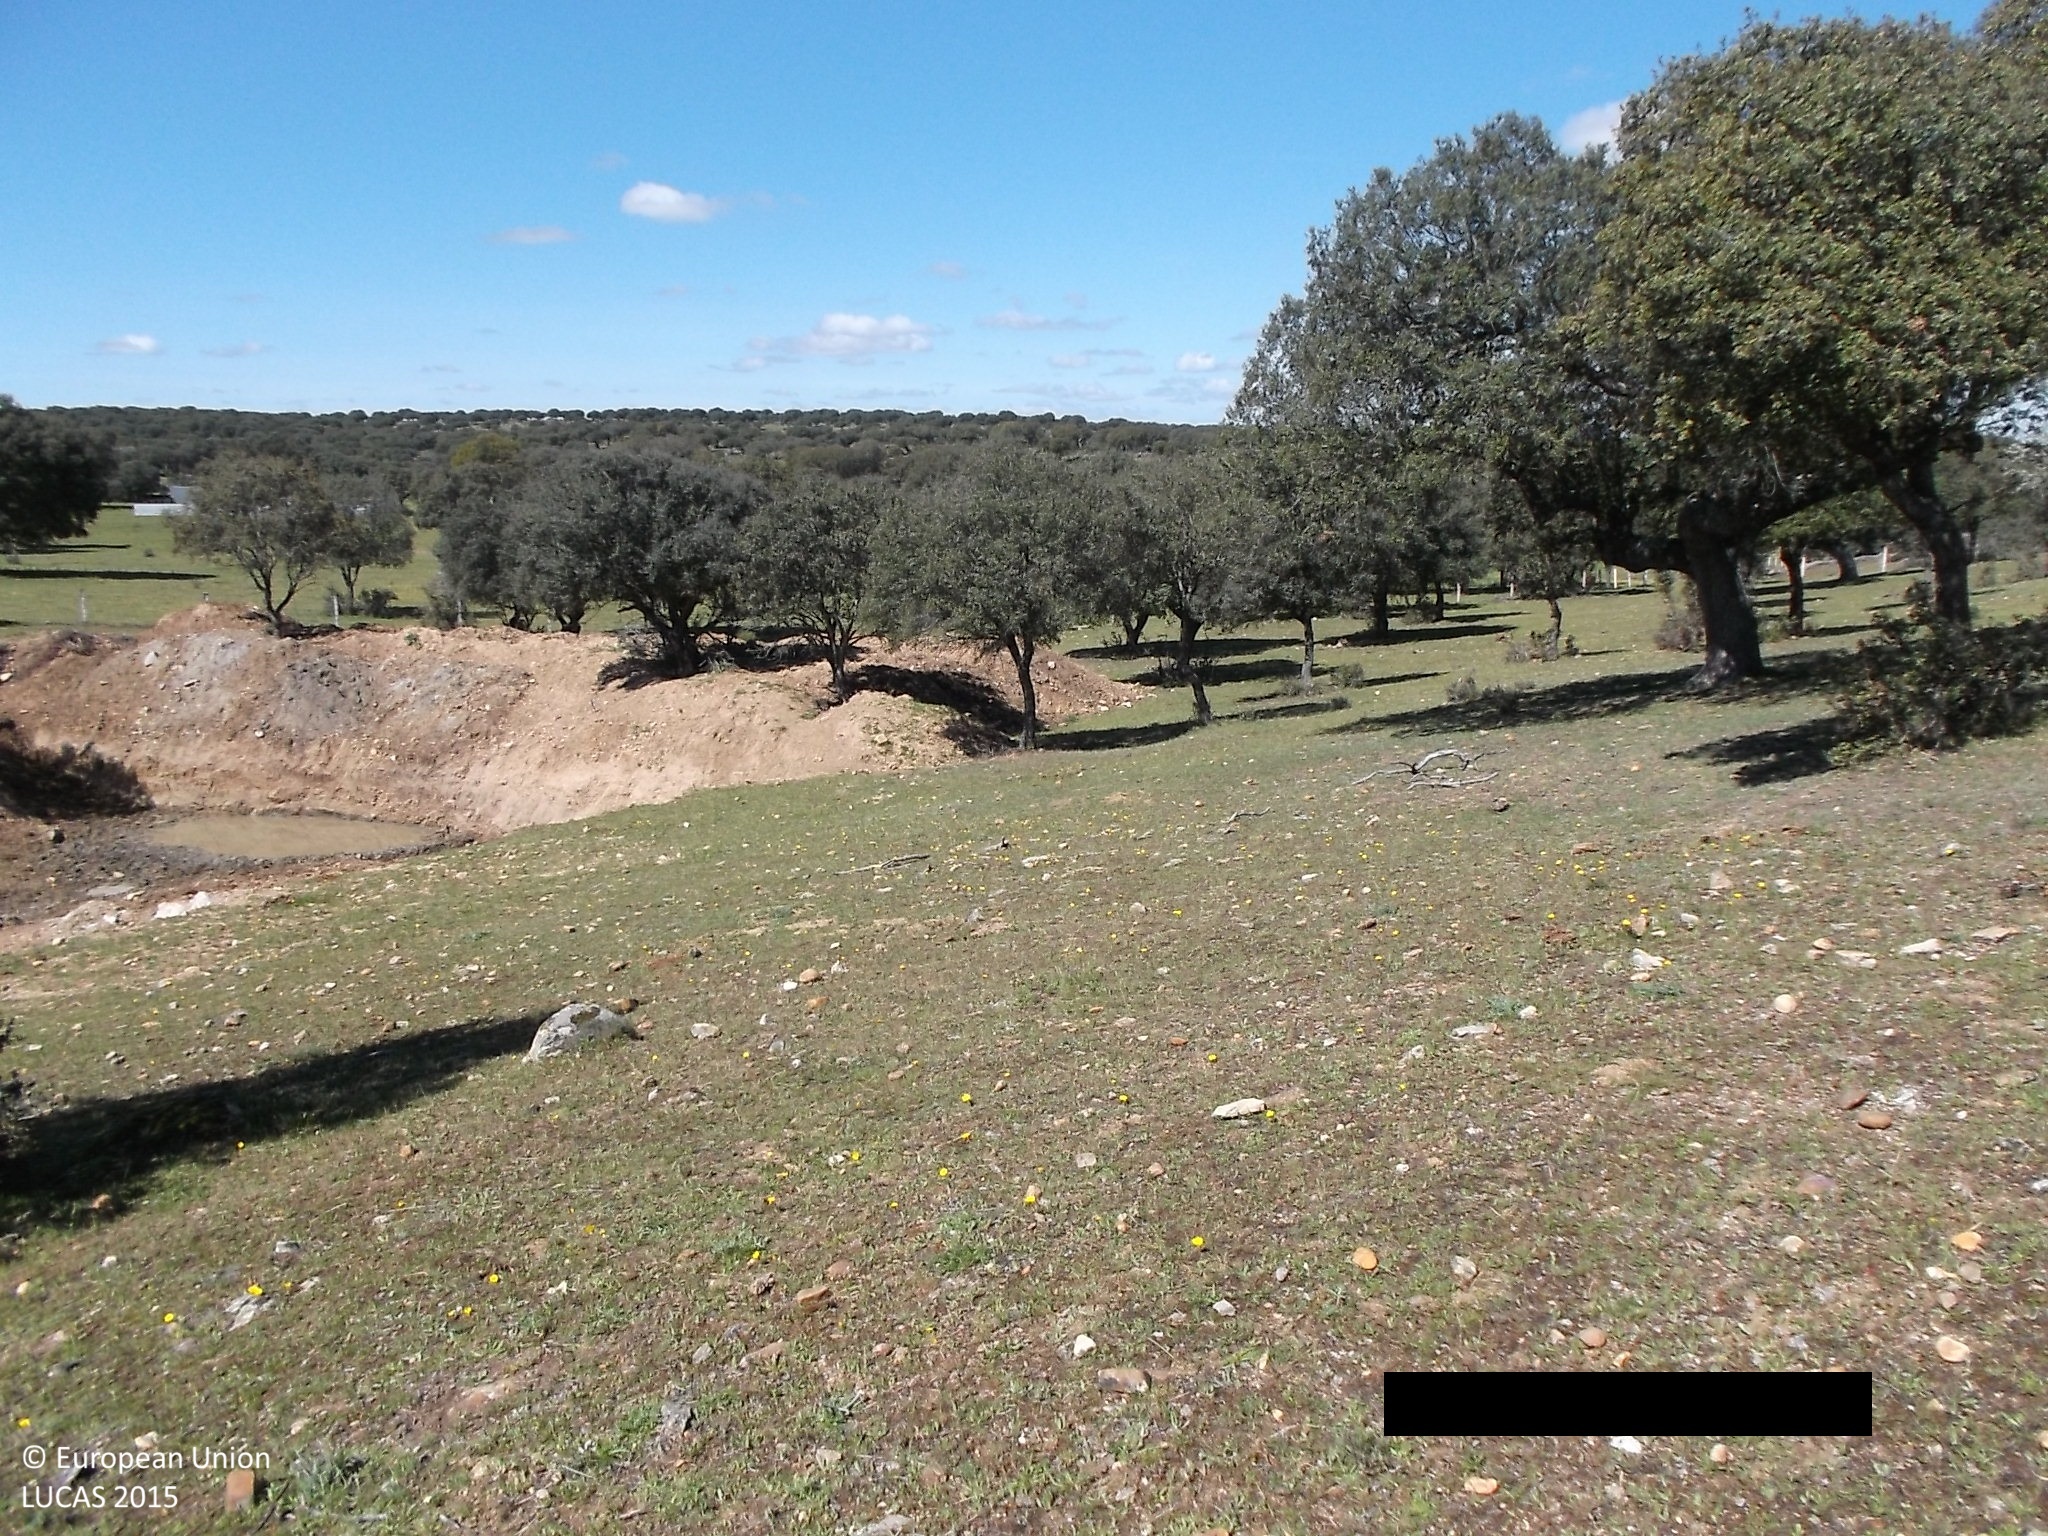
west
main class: Woodland
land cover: Broadleaved woodland
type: broadleaved evergreen forest
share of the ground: 25 - 50 %
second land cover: Grassland without tree/shrub cover
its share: 50 - 75 %
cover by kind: herbaceous plants 50 %, broadleaved forest trees 30 %, shrubs 20 %
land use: Forestry
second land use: Agriculture (excluding fallow land and kitchen gardens)
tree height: < 5 m
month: April
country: ES
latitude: 41.0722
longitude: -5.9249
